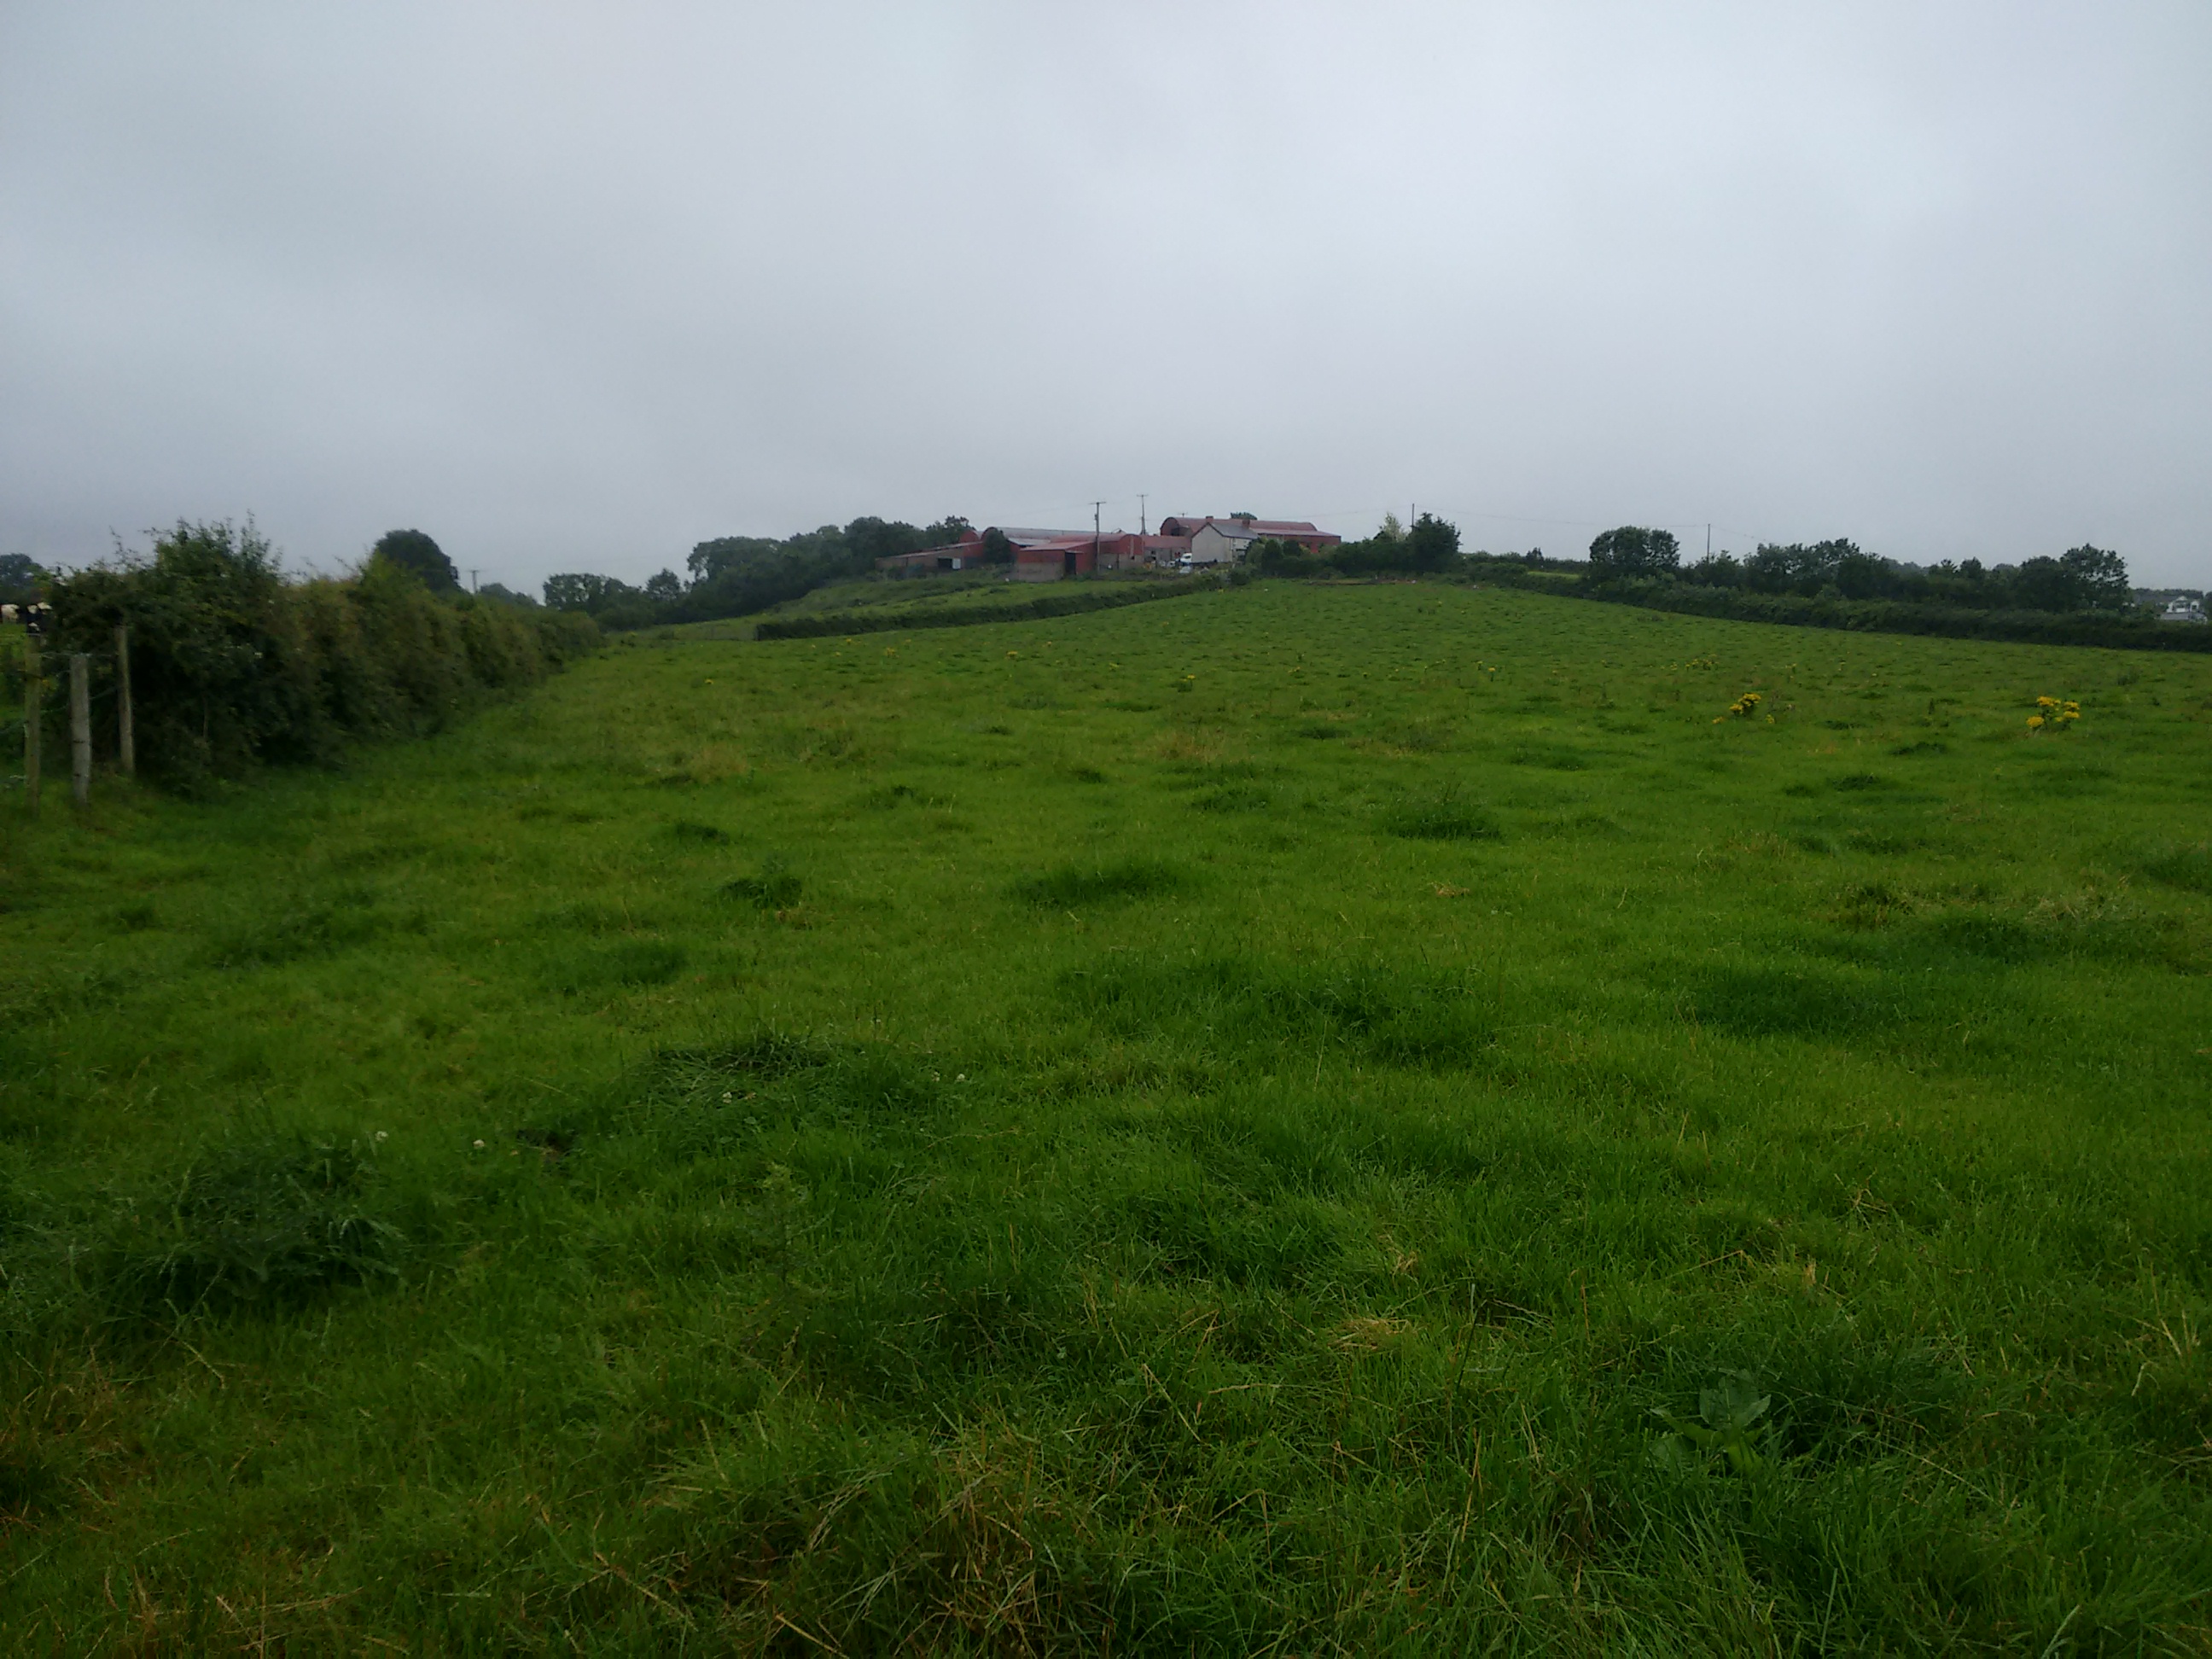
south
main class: Grassland
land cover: Grassland without tree/shrub cover
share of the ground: > 75 %
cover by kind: herbaceous plants 100 %
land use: Agriculture (excluding fallow land and kitchen gardens)
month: August
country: GB
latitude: 54.8609
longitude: -6.5609
